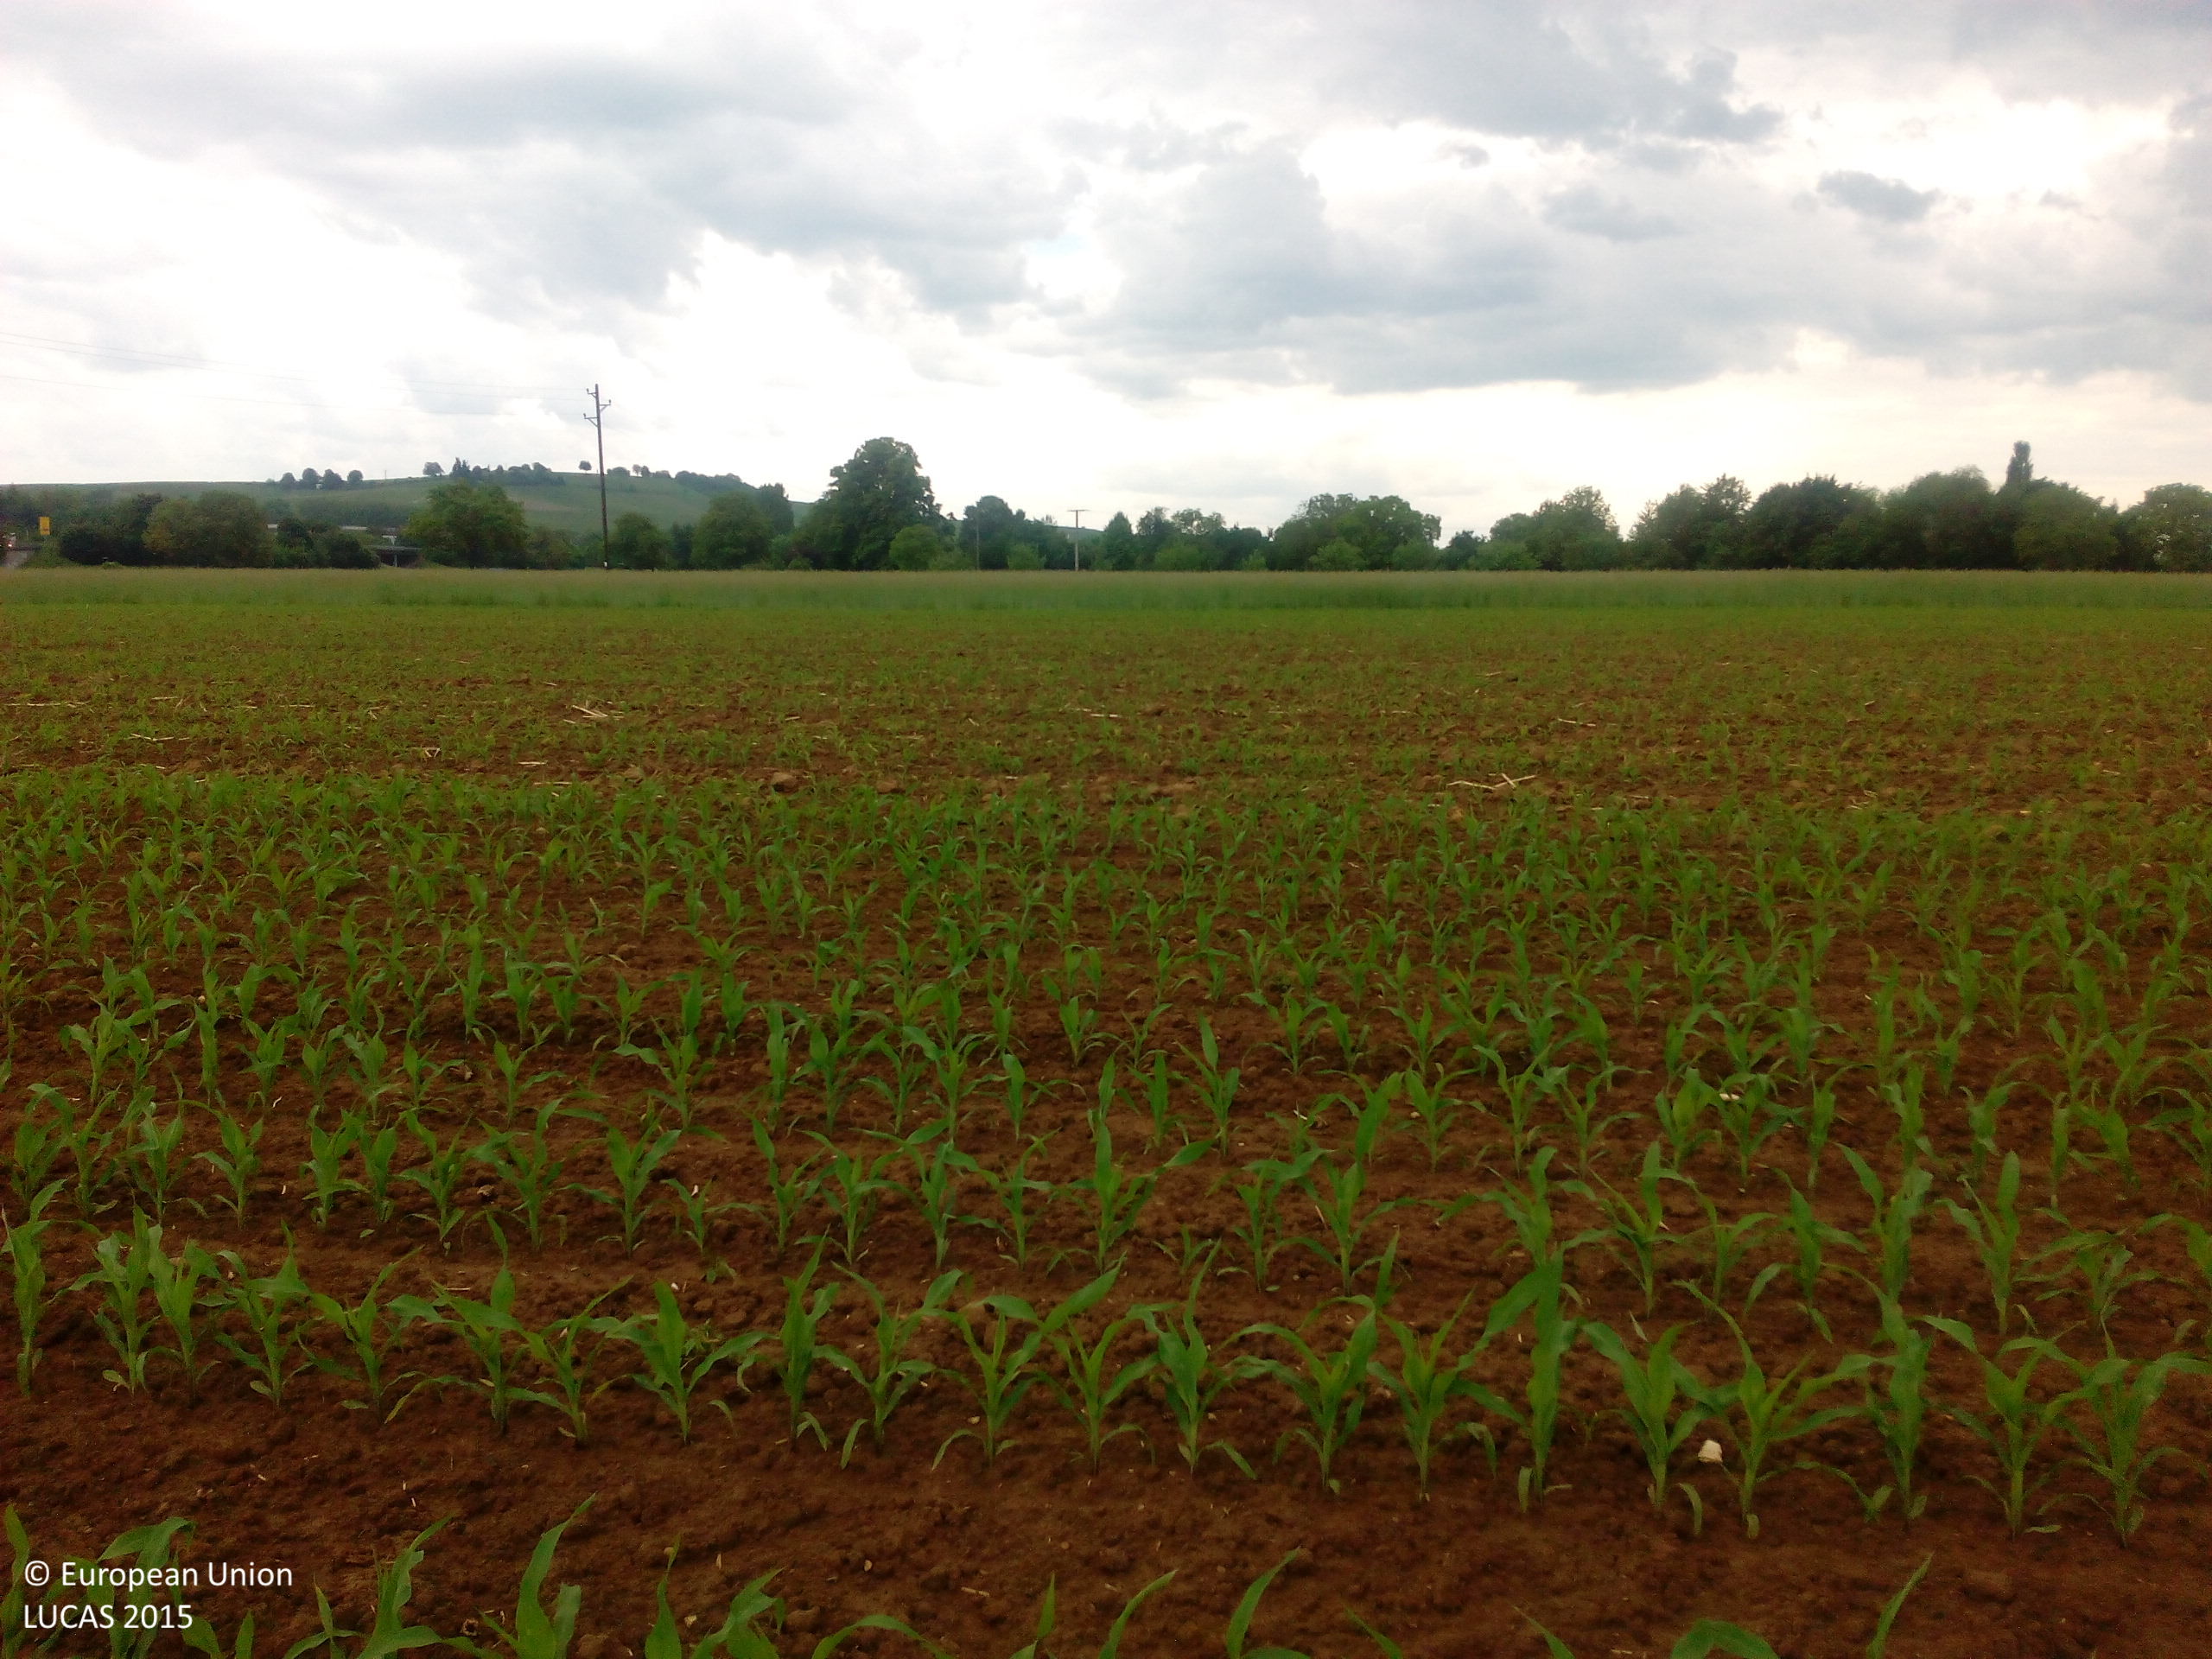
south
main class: Cropland
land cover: Maize
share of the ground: 25 - 50 %
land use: Agriculture (excluding fallow land and kitchen gardens)
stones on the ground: < 10 %
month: May
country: DE
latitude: 47.8196
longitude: 7.6106
